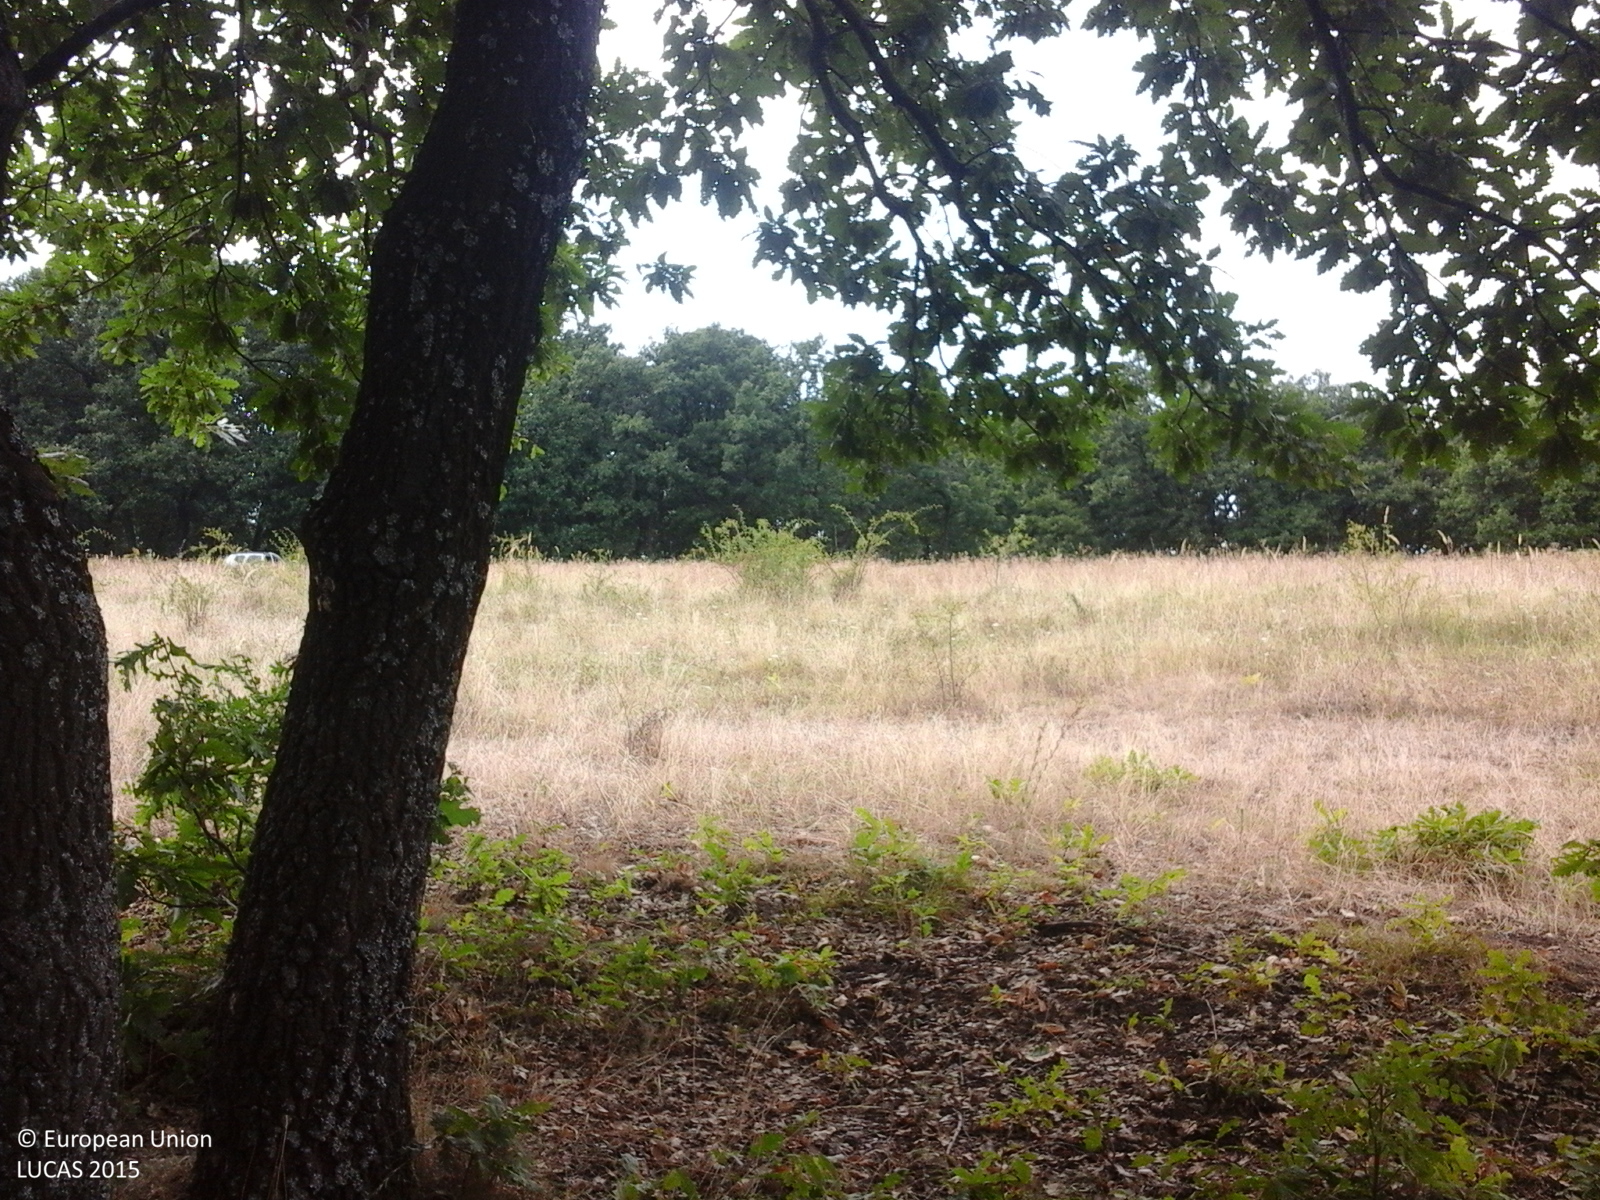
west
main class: Woodland
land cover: Broadleaved woodland
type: acidophilous oak and oak-birch forest
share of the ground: > 75 %
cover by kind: broadleaved forest trees 100 %
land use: Forestry
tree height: > 5 m
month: August
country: RO
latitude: 44.6013
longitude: 23.5995
